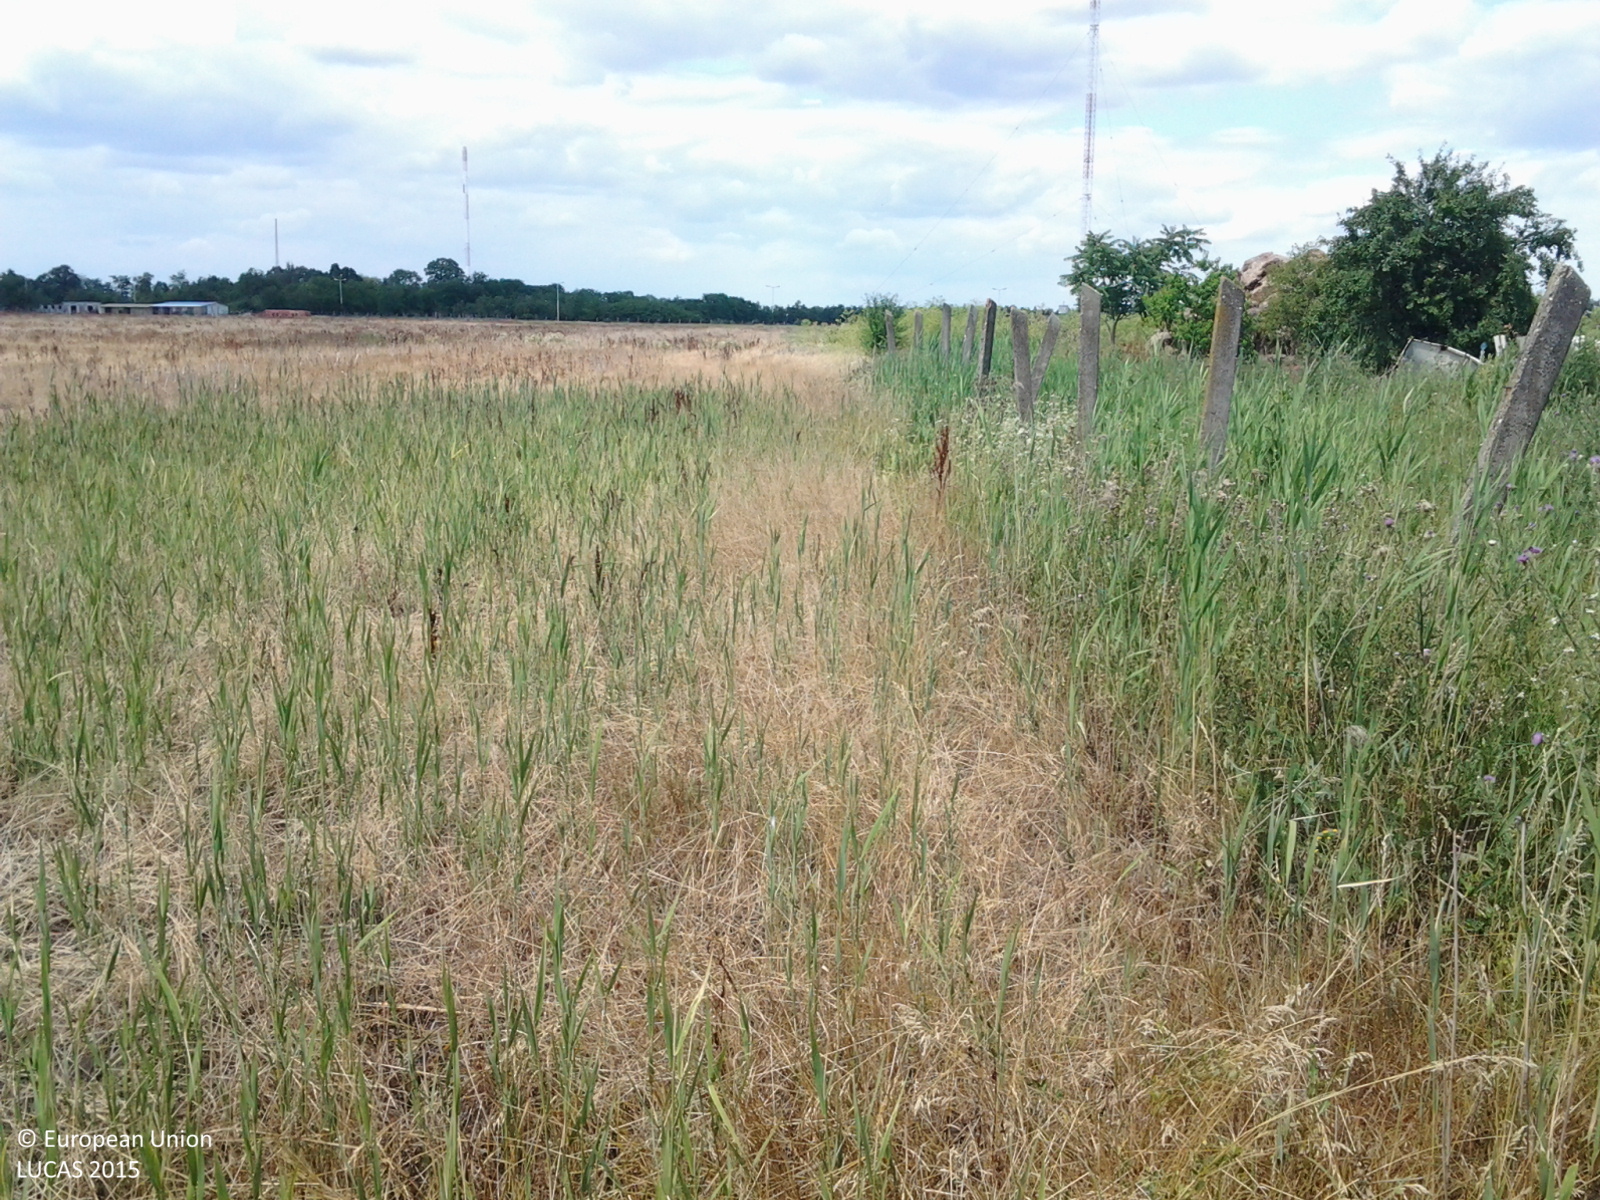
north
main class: Grassland
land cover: Grassland without tree/shrub cover
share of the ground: > 75 %
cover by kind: herbaceous plants 90 %, unconsolidated bare surface 10 %
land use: Abandoned areas
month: June
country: HU
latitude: 47.1843
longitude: 20.2278
